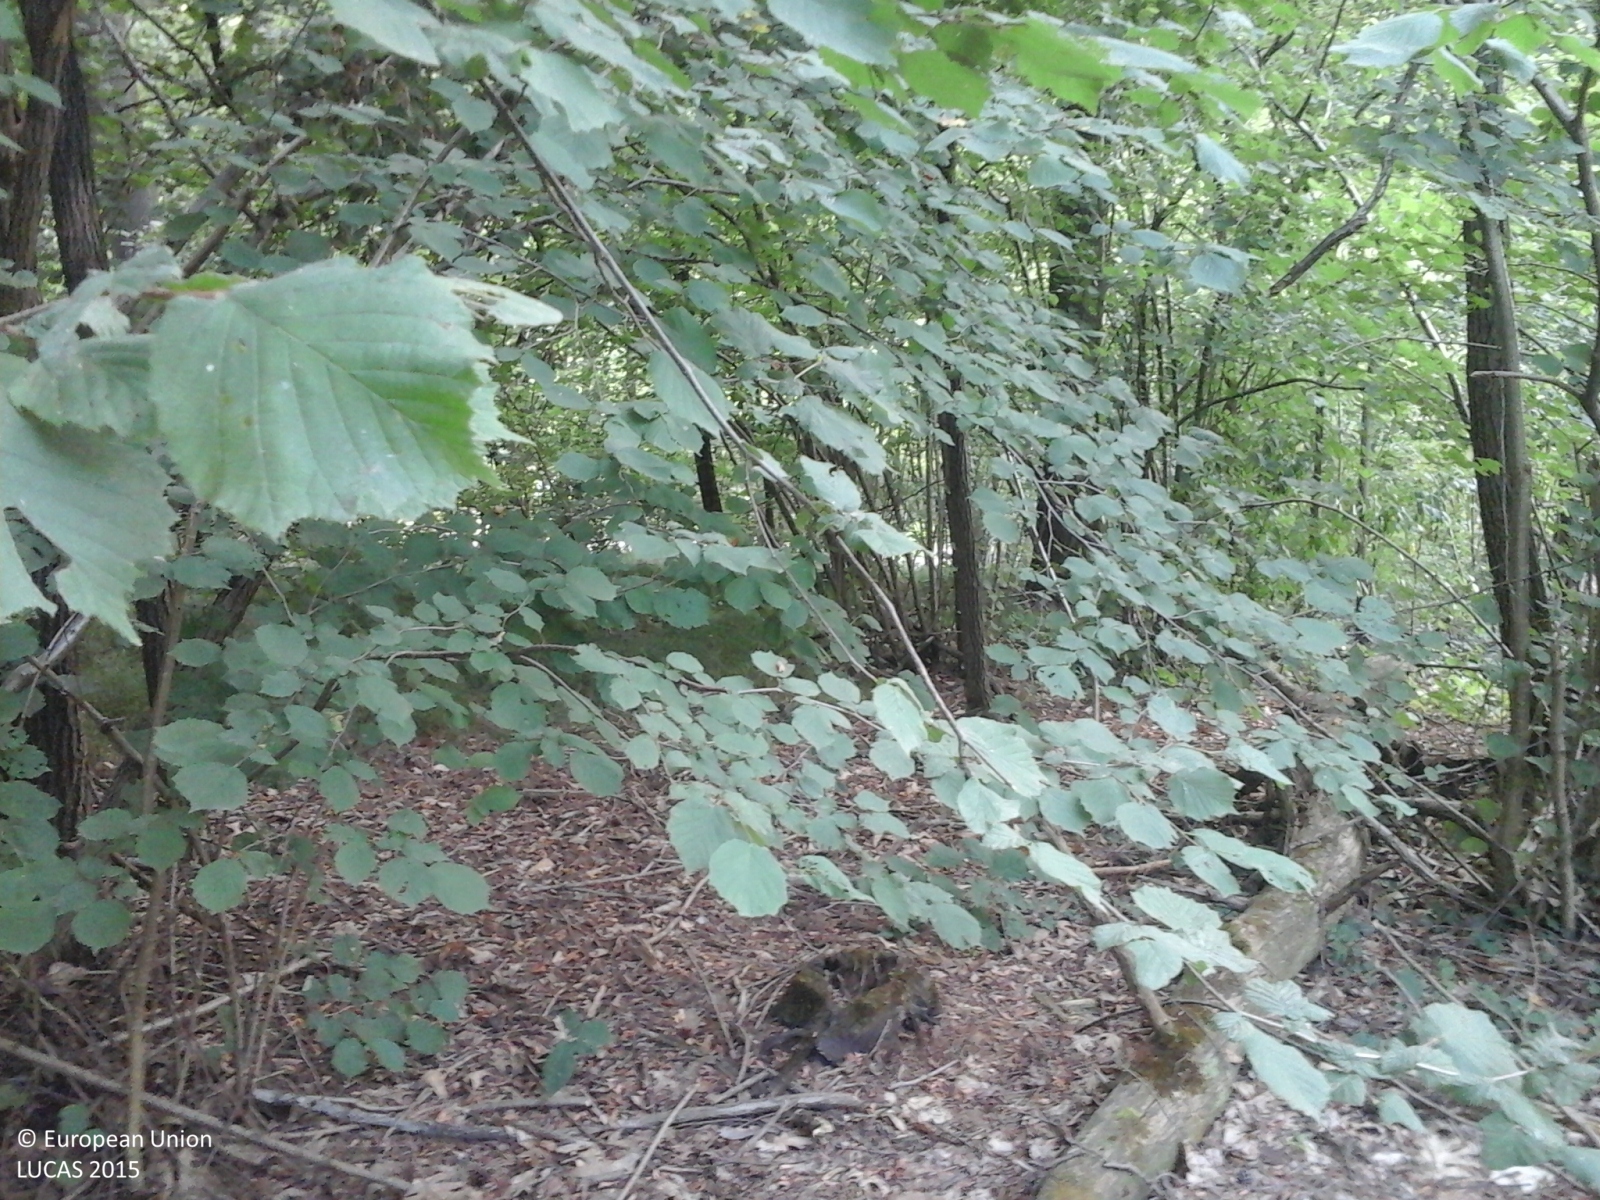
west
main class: Woodland
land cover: Other mixed woodland
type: thermophilous deciduous forest
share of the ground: > 75 %
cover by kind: coniferous forest trees 40 %, broadleaved forest trees 30 %, shrubs 25 %, herbaceous plants 5 %
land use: Forestry
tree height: > 5 m
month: July
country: IT
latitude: 45.7133
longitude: 8.7559
